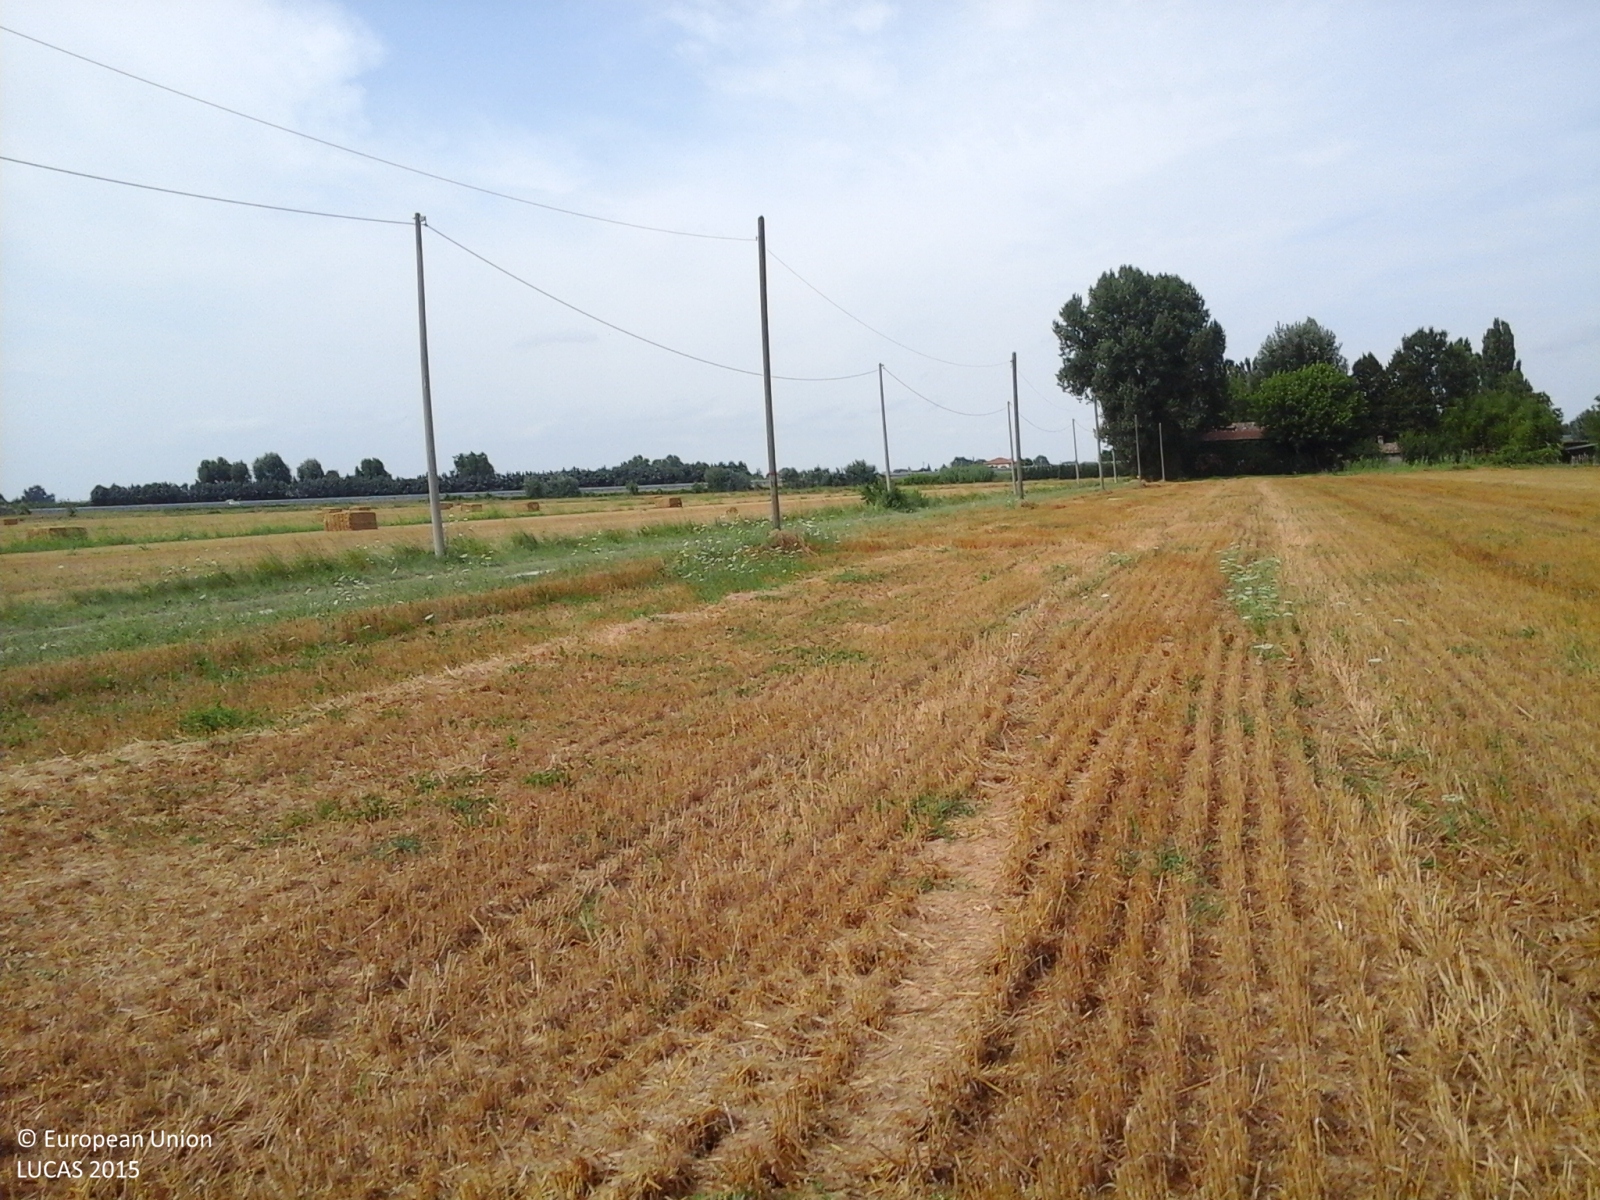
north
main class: Cropland
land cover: Common wheat
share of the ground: > 75 %
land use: Agriculture (excluding fallow land and kitchen gardens)
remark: Harvested field
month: July
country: IT
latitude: 44.4031
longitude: 12.0172
